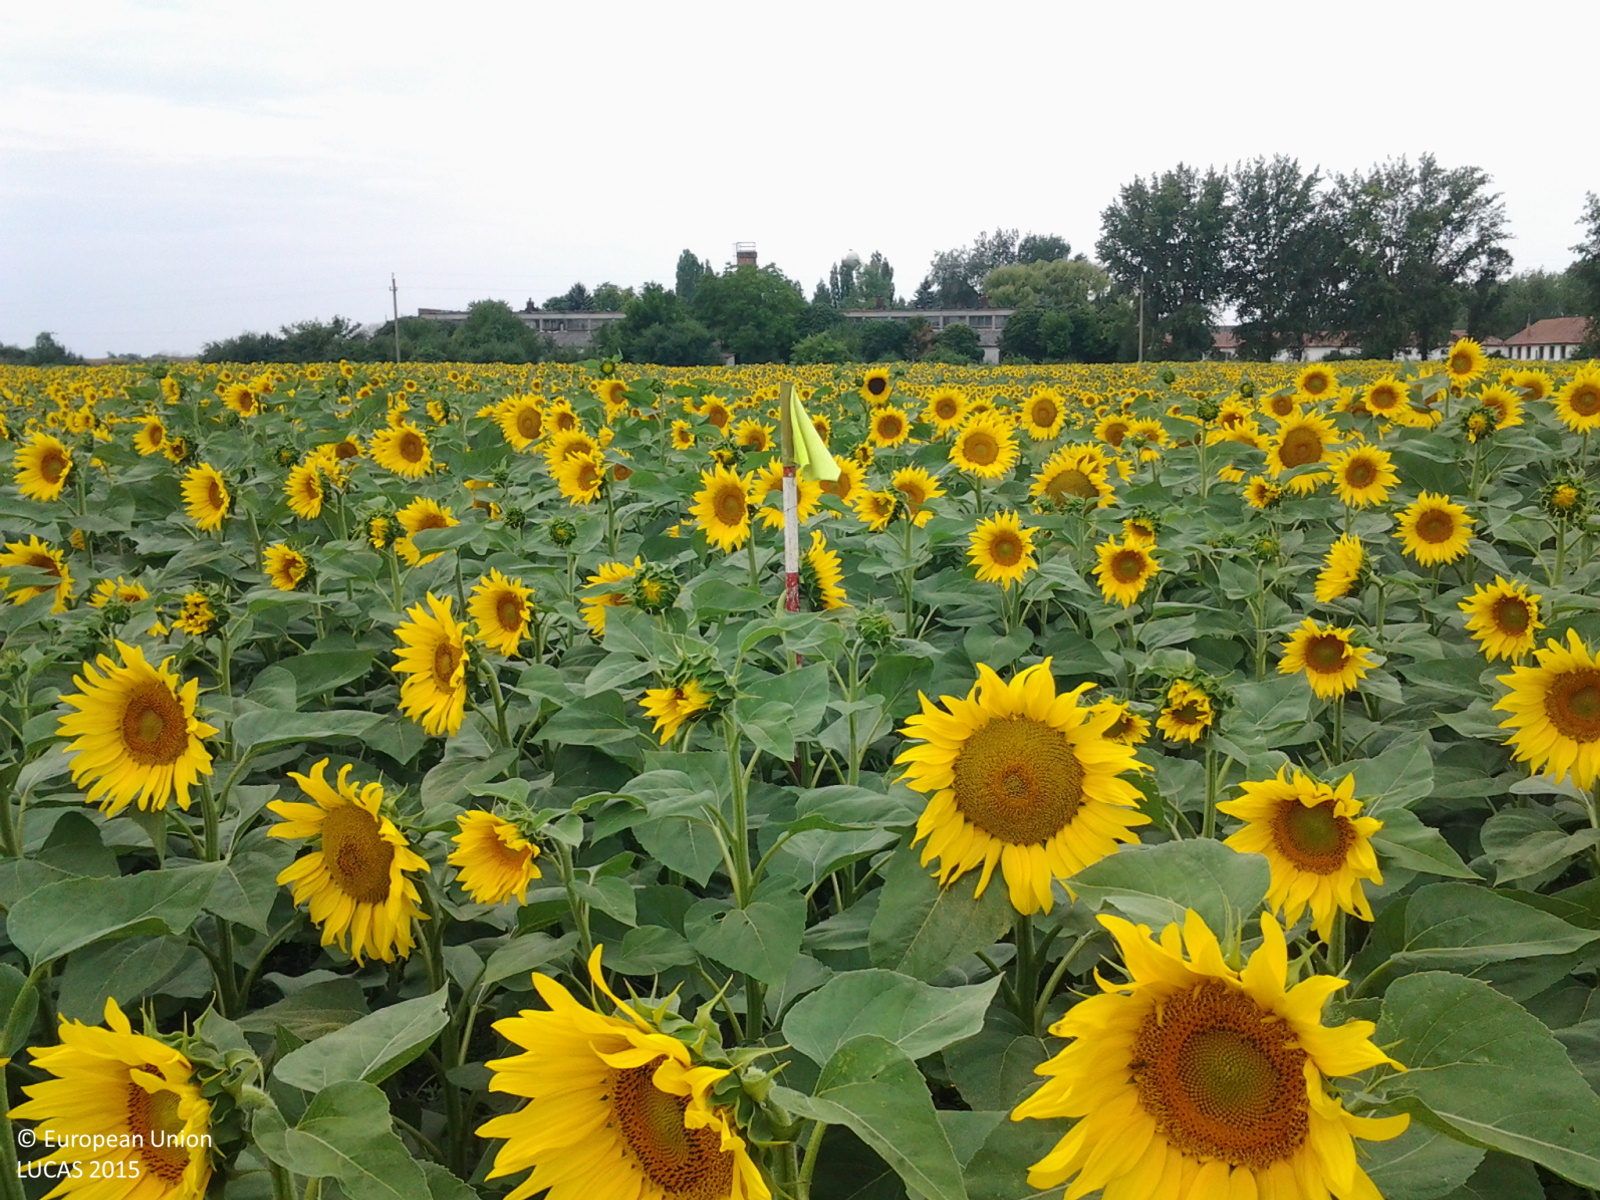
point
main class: Cropland
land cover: Sunflower
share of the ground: > 75 %
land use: Agriculture (excluding fallow land and kitchen gardens)
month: July
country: HU
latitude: 47.3295
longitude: 20.4170
